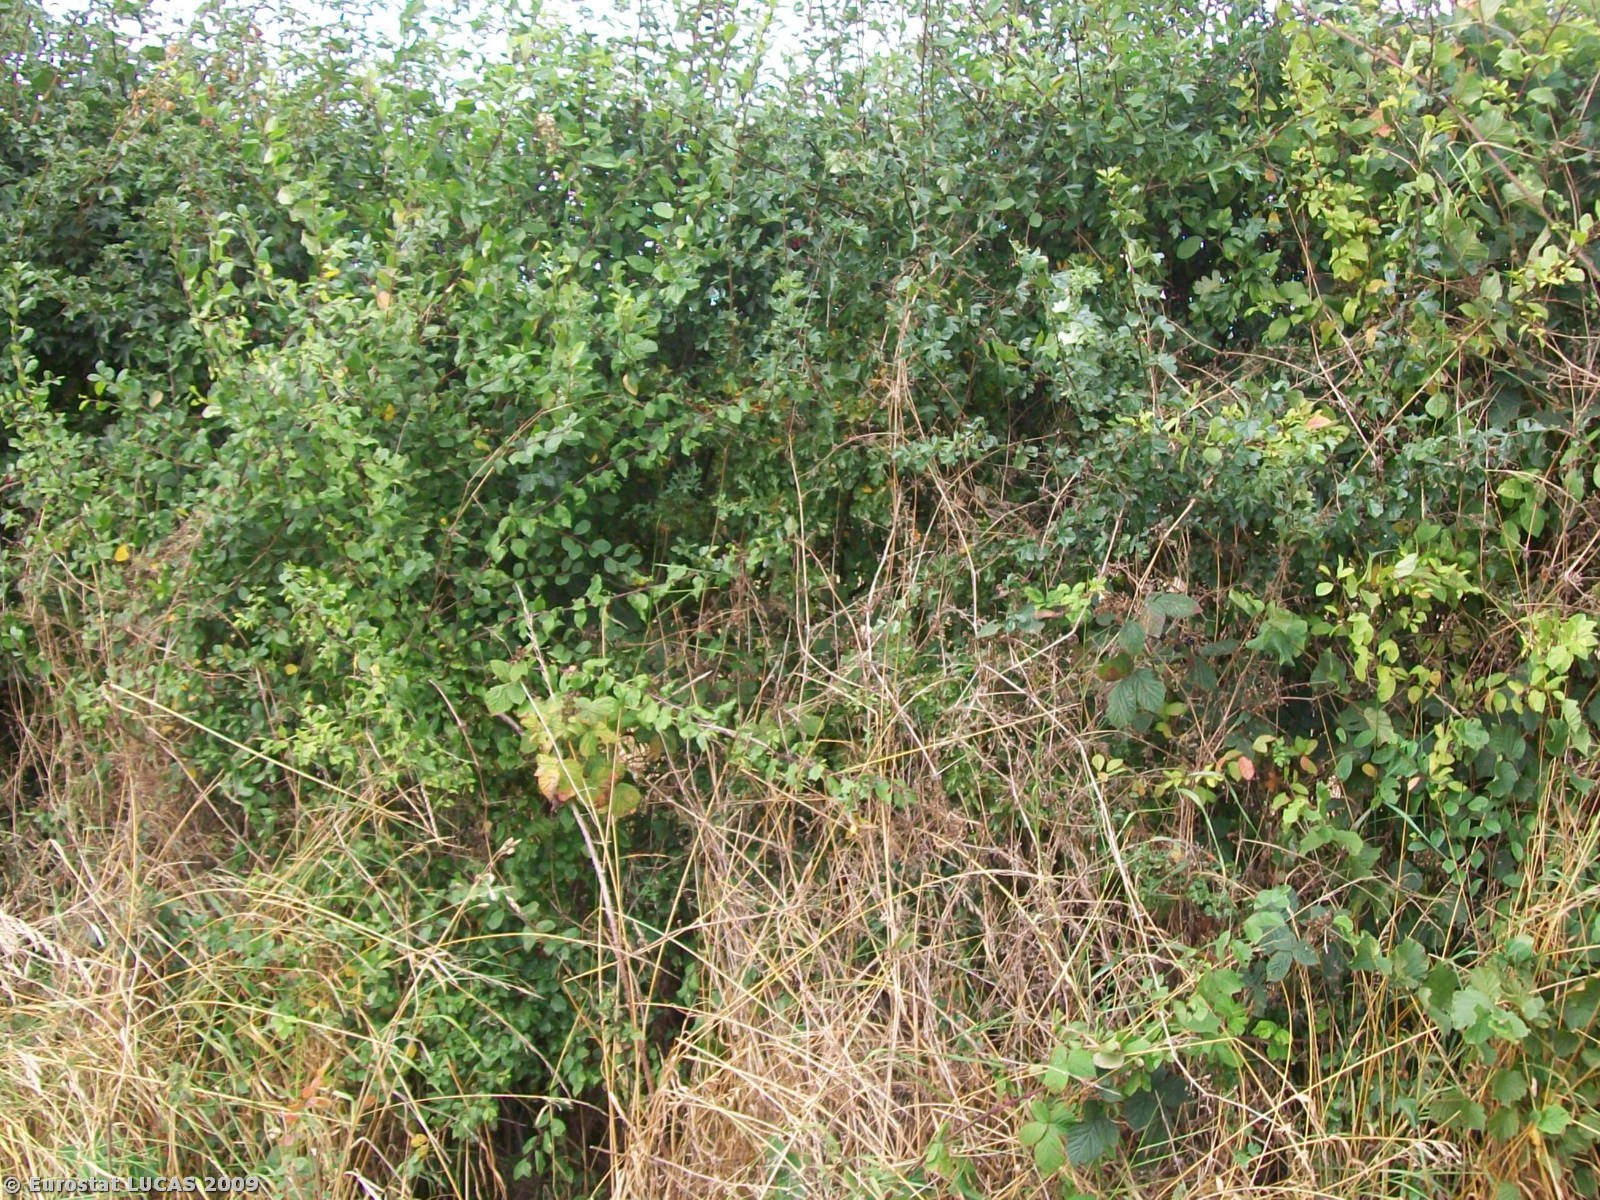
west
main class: Cropland
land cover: Common wheat
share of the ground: < 10 %
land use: Agriculture (excluding fallow land and kitchen gardens)
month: September
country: GB
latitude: 52.5832
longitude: -2.5380
